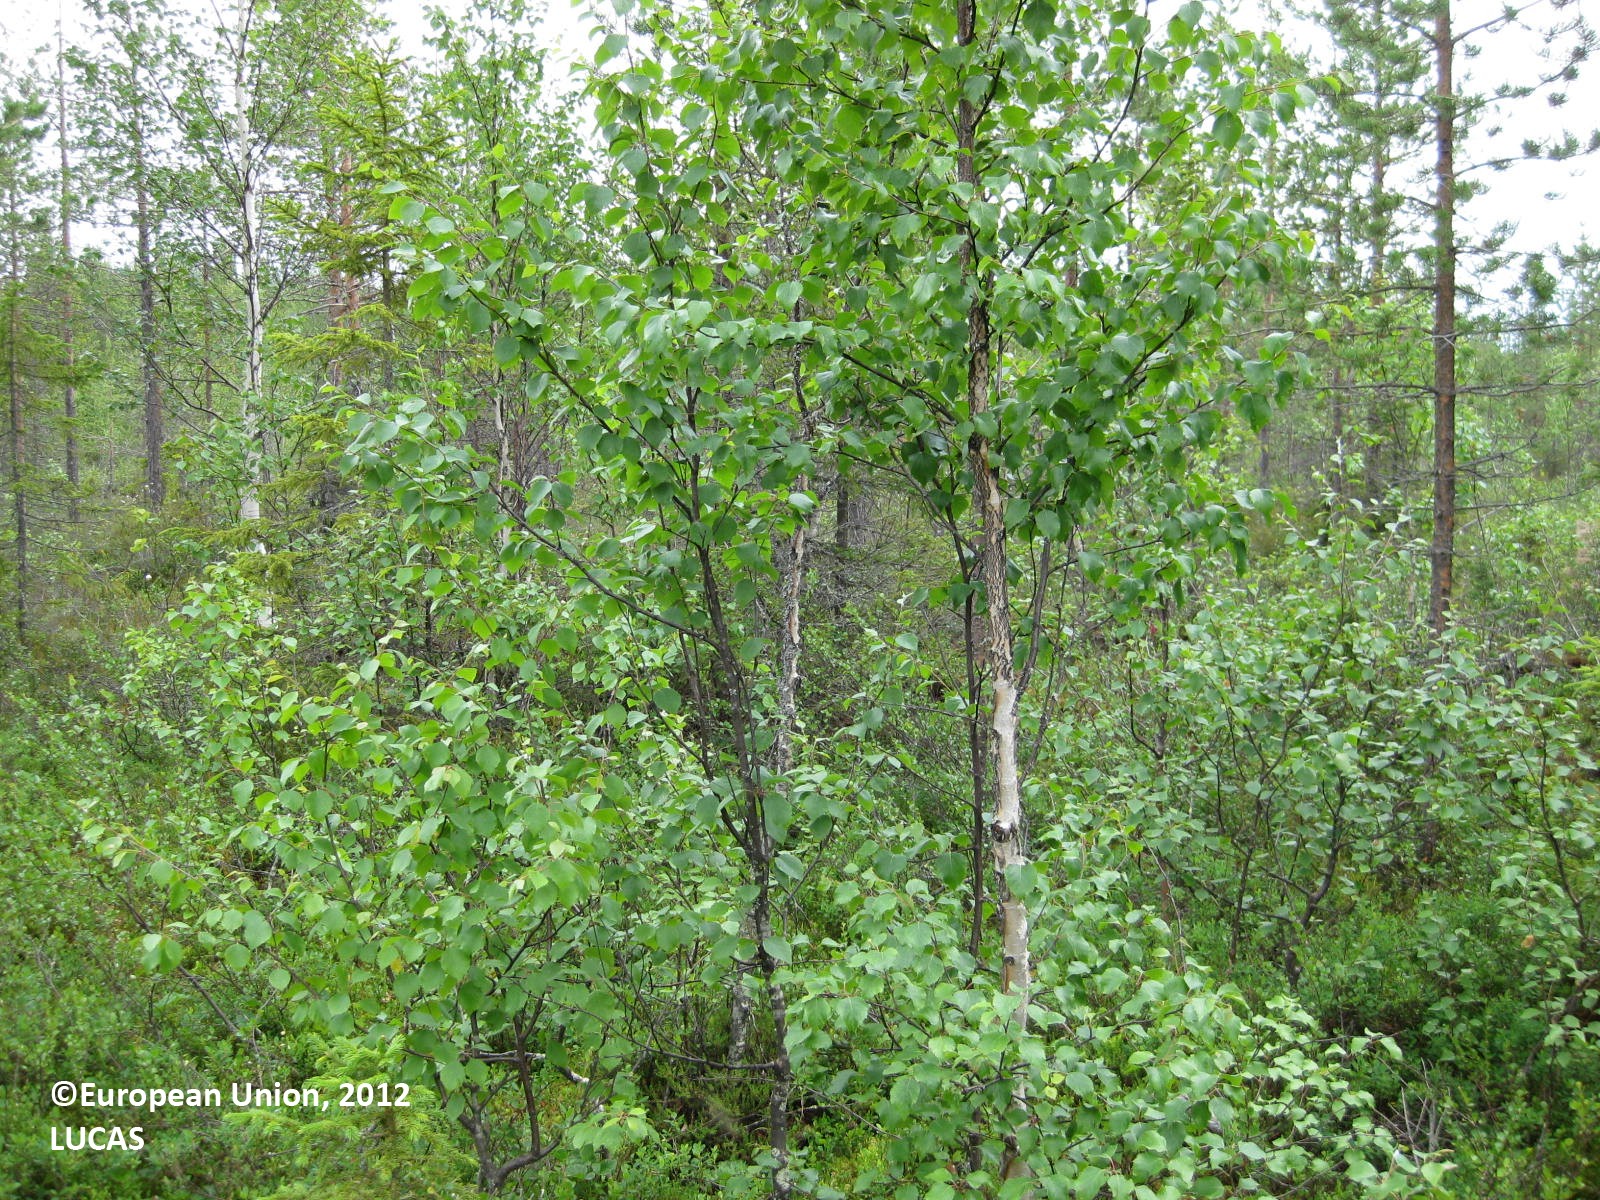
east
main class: Woodland
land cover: Other mixed woodland
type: boreal forest
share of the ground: 25 - 50 %
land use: Forestry
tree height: > 5 m
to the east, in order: Other mixed woodland; Ditches and canals; Pine dominated coniferous woodland; Ditches and canals; Pine dominated coniferous woodland; Ditches and canals; Other mixed woodland; Pine dominated coniferous woodland; Ditches and canals; Pine dominated coniferous woodland; Ditches and canals; Pine dominated coniferous woodland; Tracks; Abandoned hedges; Tracks; Abandoned hedges; Other coniferous woodland; Ditches and canals; Other coniferous woodland; Peatbogs
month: July
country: FI
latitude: 65.4216
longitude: 28.3651
